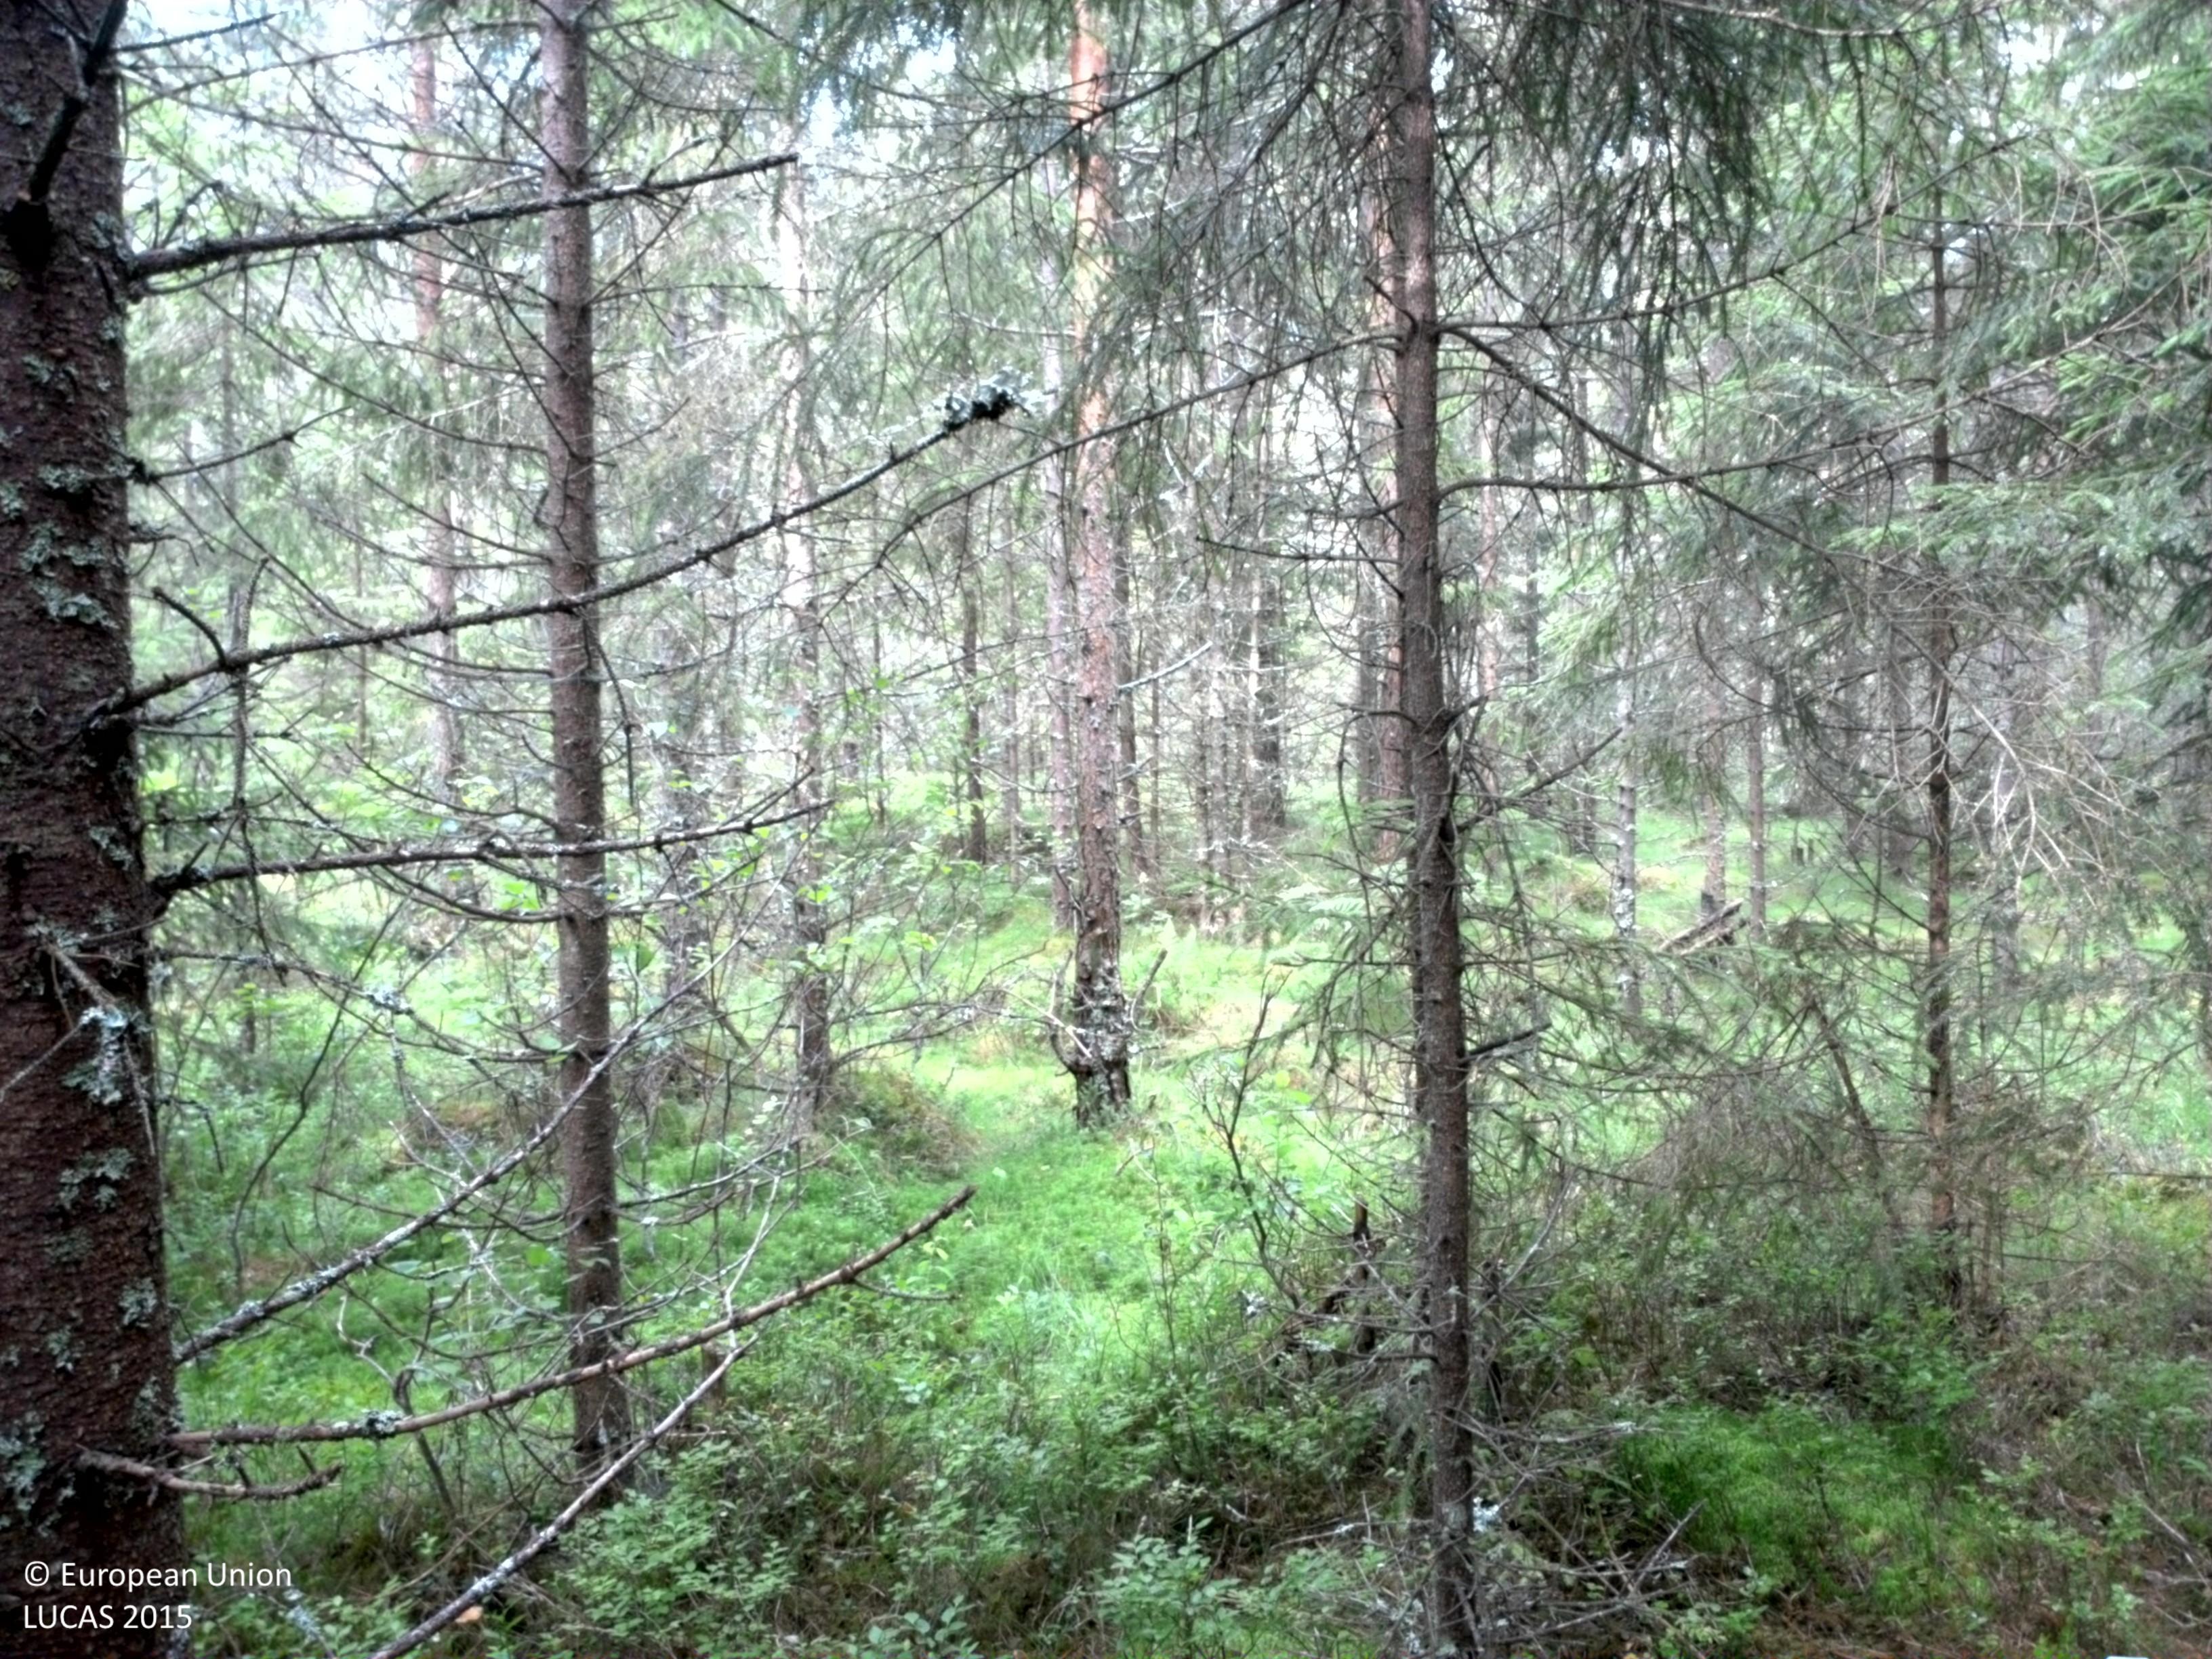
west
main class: Woodland
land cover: Other coniferous woodland
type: boreal forest
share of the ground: 50 - 75 %
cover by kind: coniferous forest trees 65 %, lichens and mosses 25 %, broadleaved forest trees 5 %, shrubs 5 %
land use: Forestry
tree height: > 5 m
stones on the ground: < 10 %
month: August
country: SE
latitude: 59.6203
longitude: 13.2716
